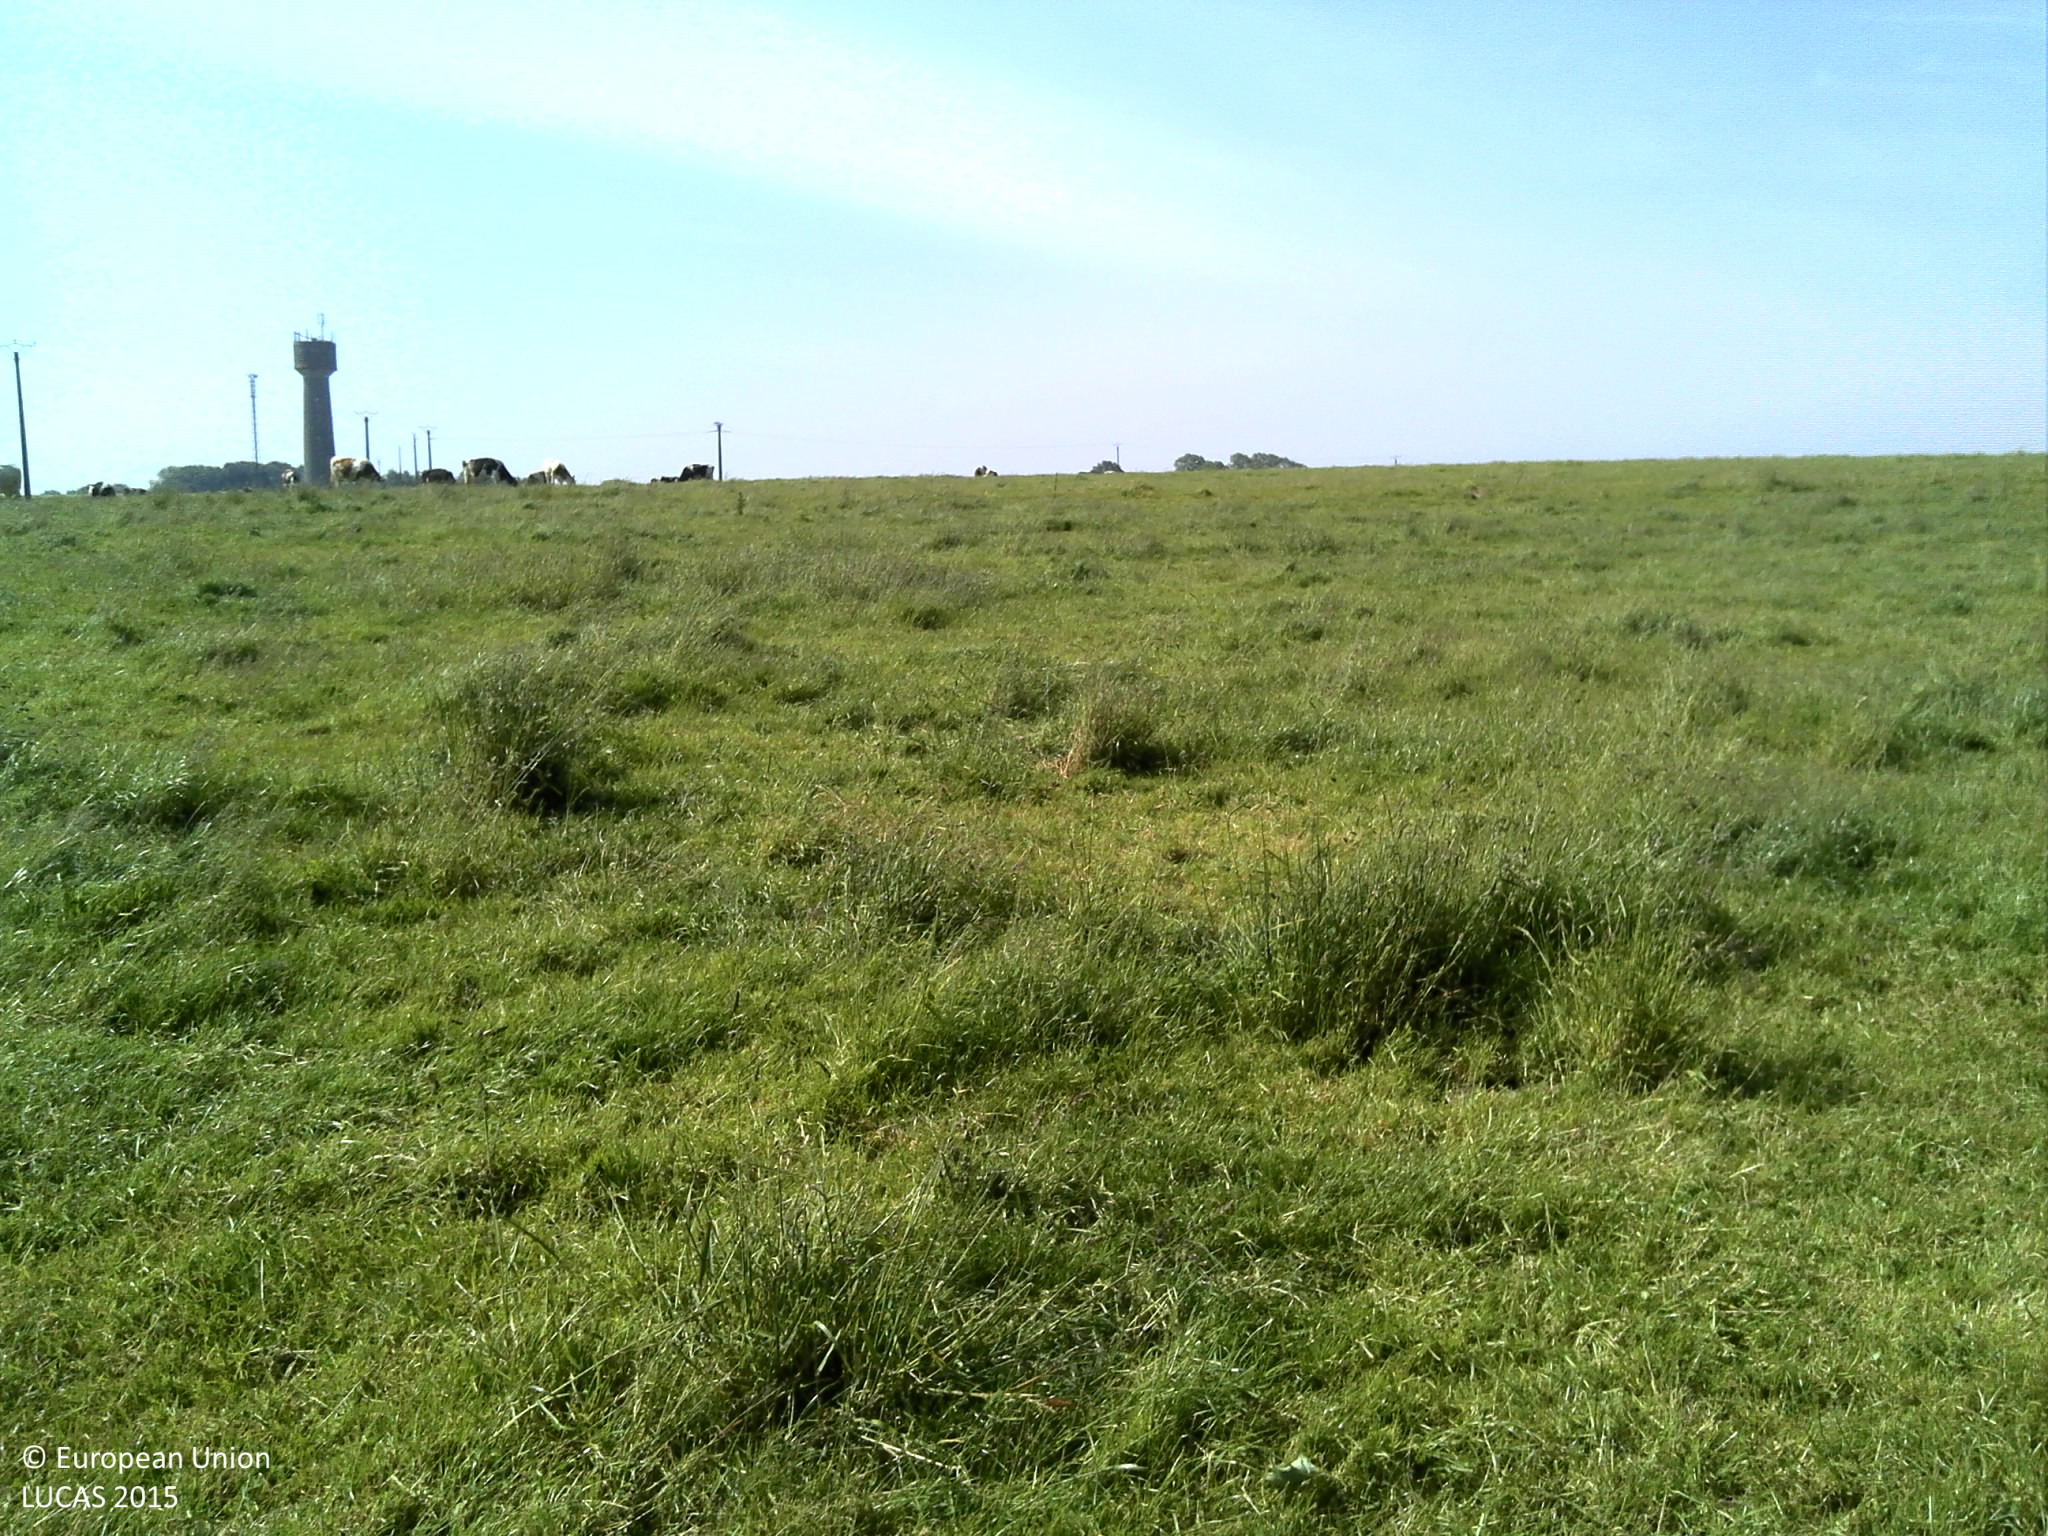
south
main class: Grassland
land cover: Grassland without tree/shrub cover
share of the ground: > 75 %
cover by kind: herbaceous plants 100 %
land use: Agriculture (excluding fallow land and kitchen gardens)
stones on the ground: < 10 %
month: June
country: FR
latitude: 49.6576
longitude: 0.2601
